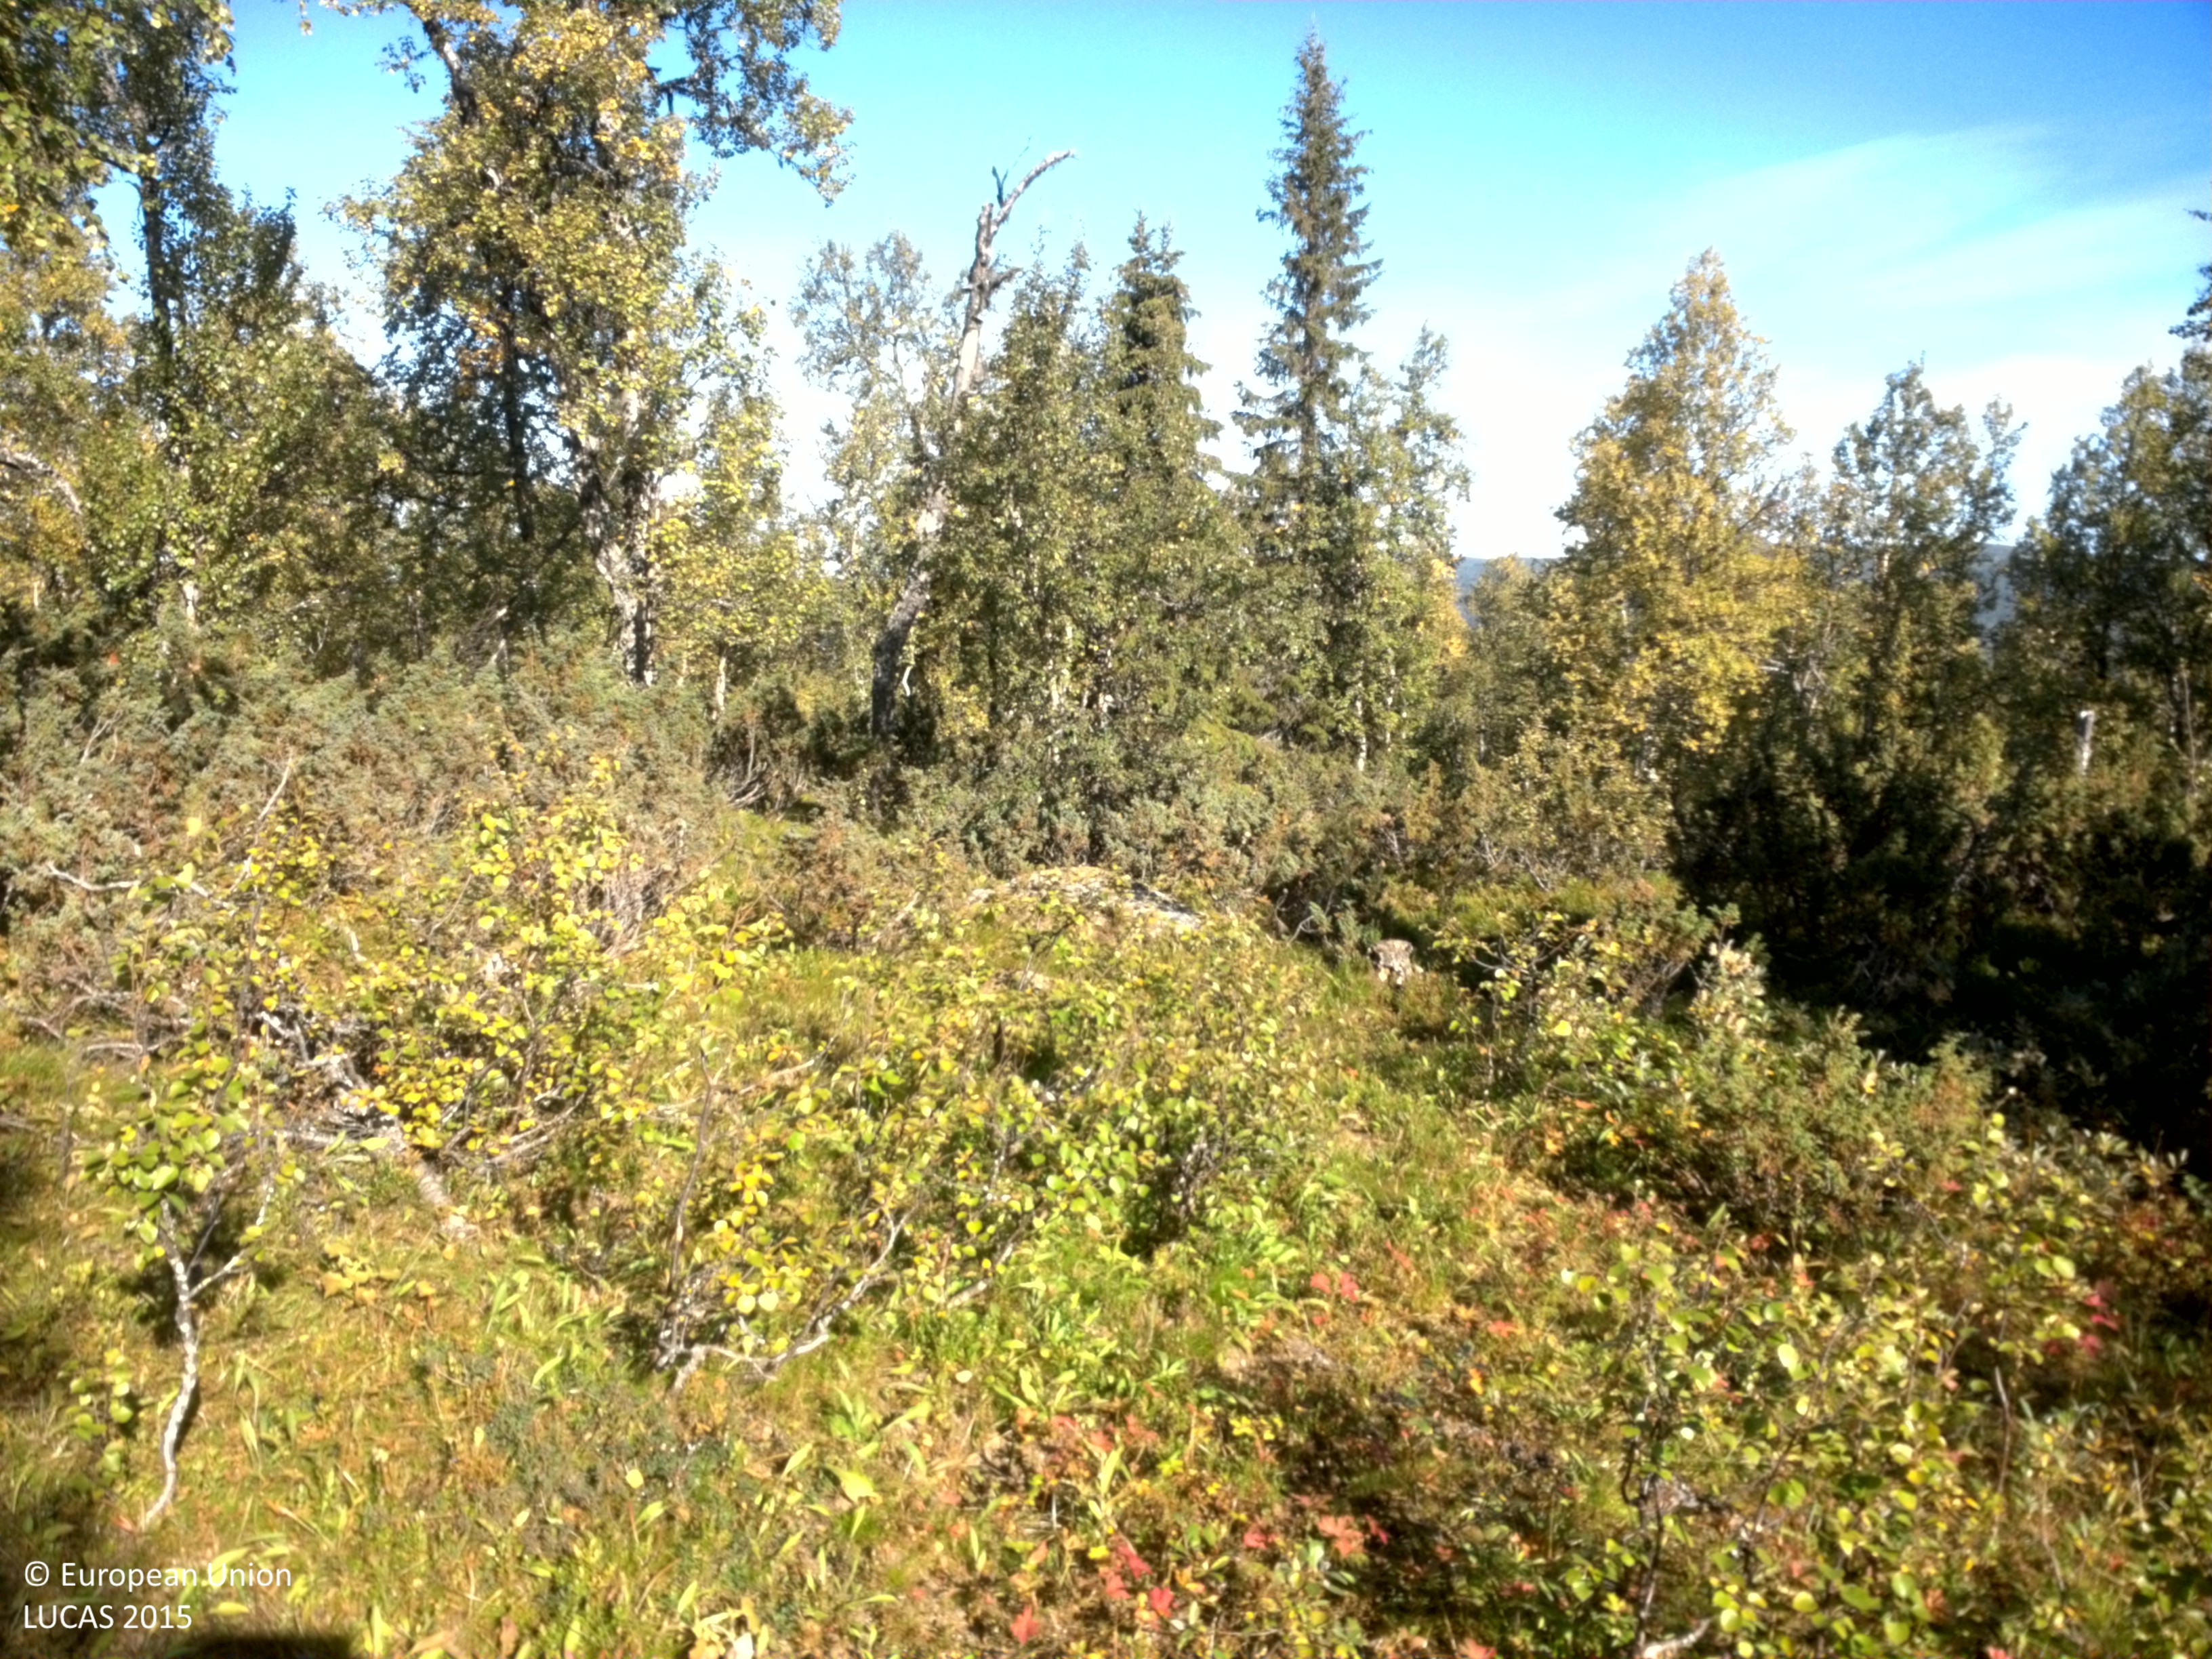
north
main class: Woodland
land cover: Broadleaved woodland
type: non-riverine alder, birch or aspen forest
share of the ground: 10 - 25 %
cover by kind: shrubs 50 %, herbaceous plants 30 %, broadleaved forest trees 15 %, lichens and mosses 5 %
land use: Amenities, museums, leisure
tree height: > 5 m
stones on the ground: < 10 %
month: September
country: SE
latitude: 65.8461
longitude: 16.4202
